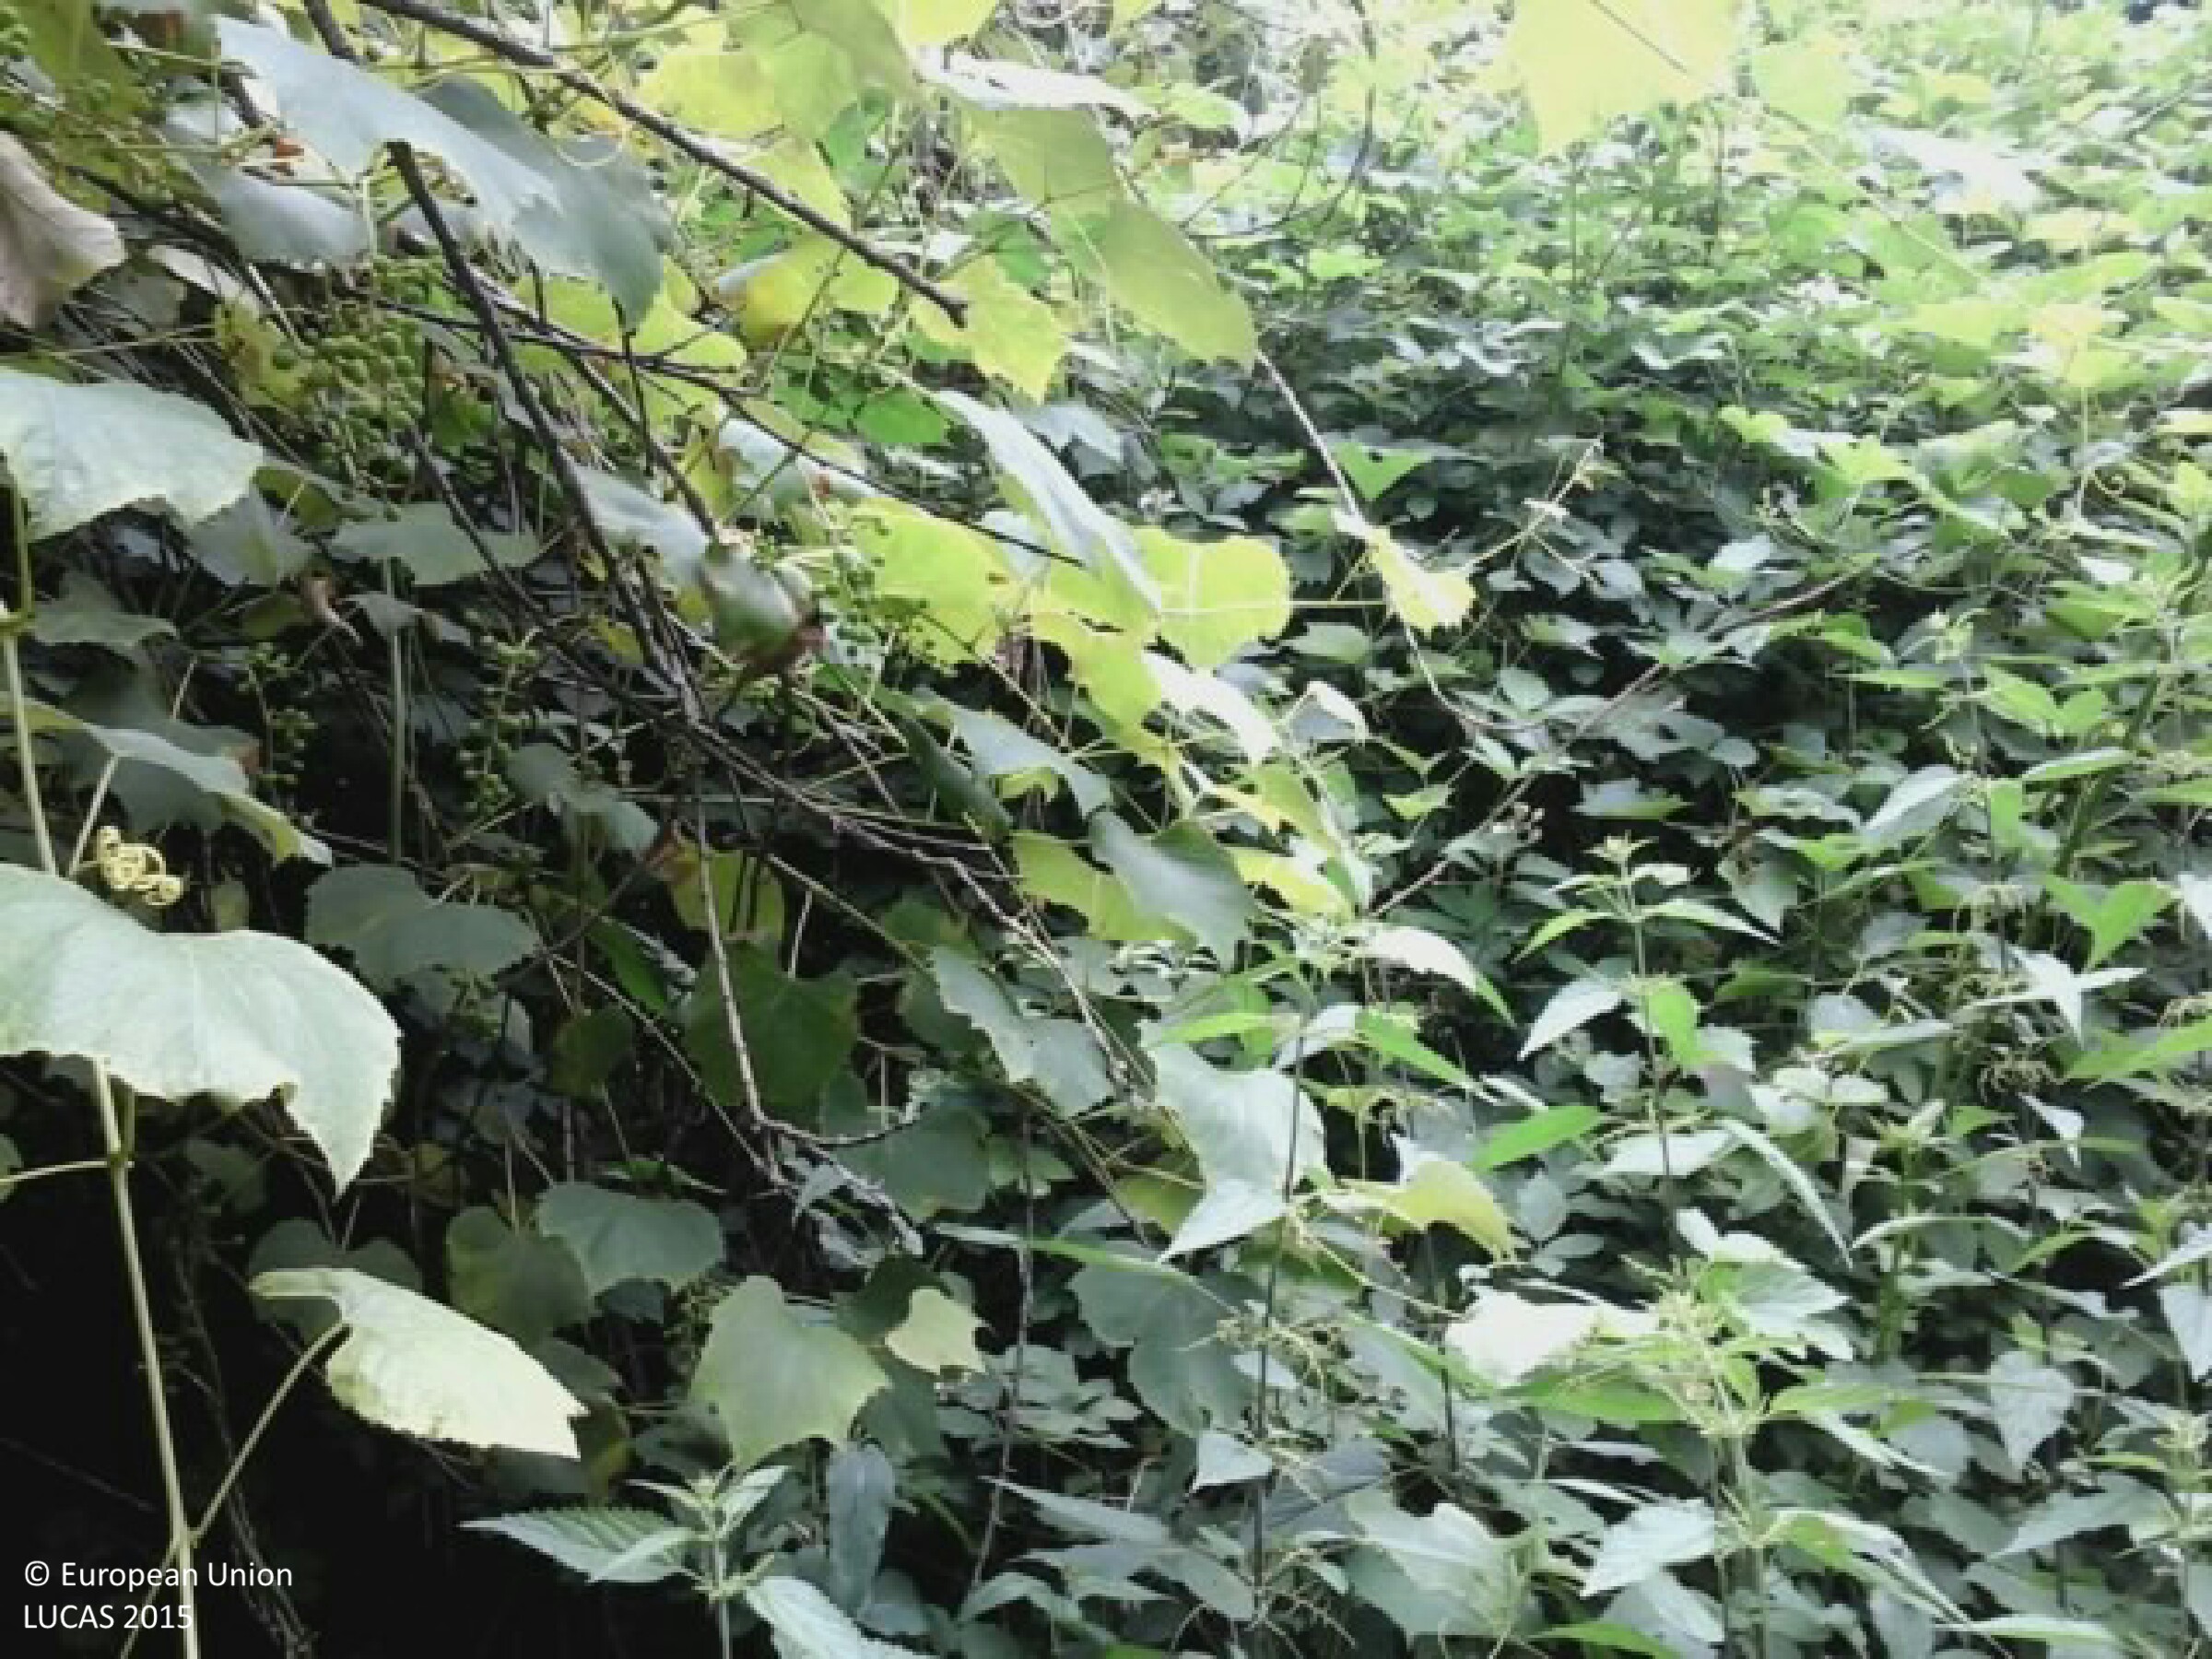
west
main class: Woodland
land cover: Broadleaved woodland
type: mesophytic deciduous forest
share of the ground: > 75 %
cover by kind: broadleaved forest trees 75 %, shrubs 15 %, herbaceous plants 10 %
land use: Forestry
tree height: > 5 m
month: June
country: HU
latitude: 46.2809
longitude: 17.8317
